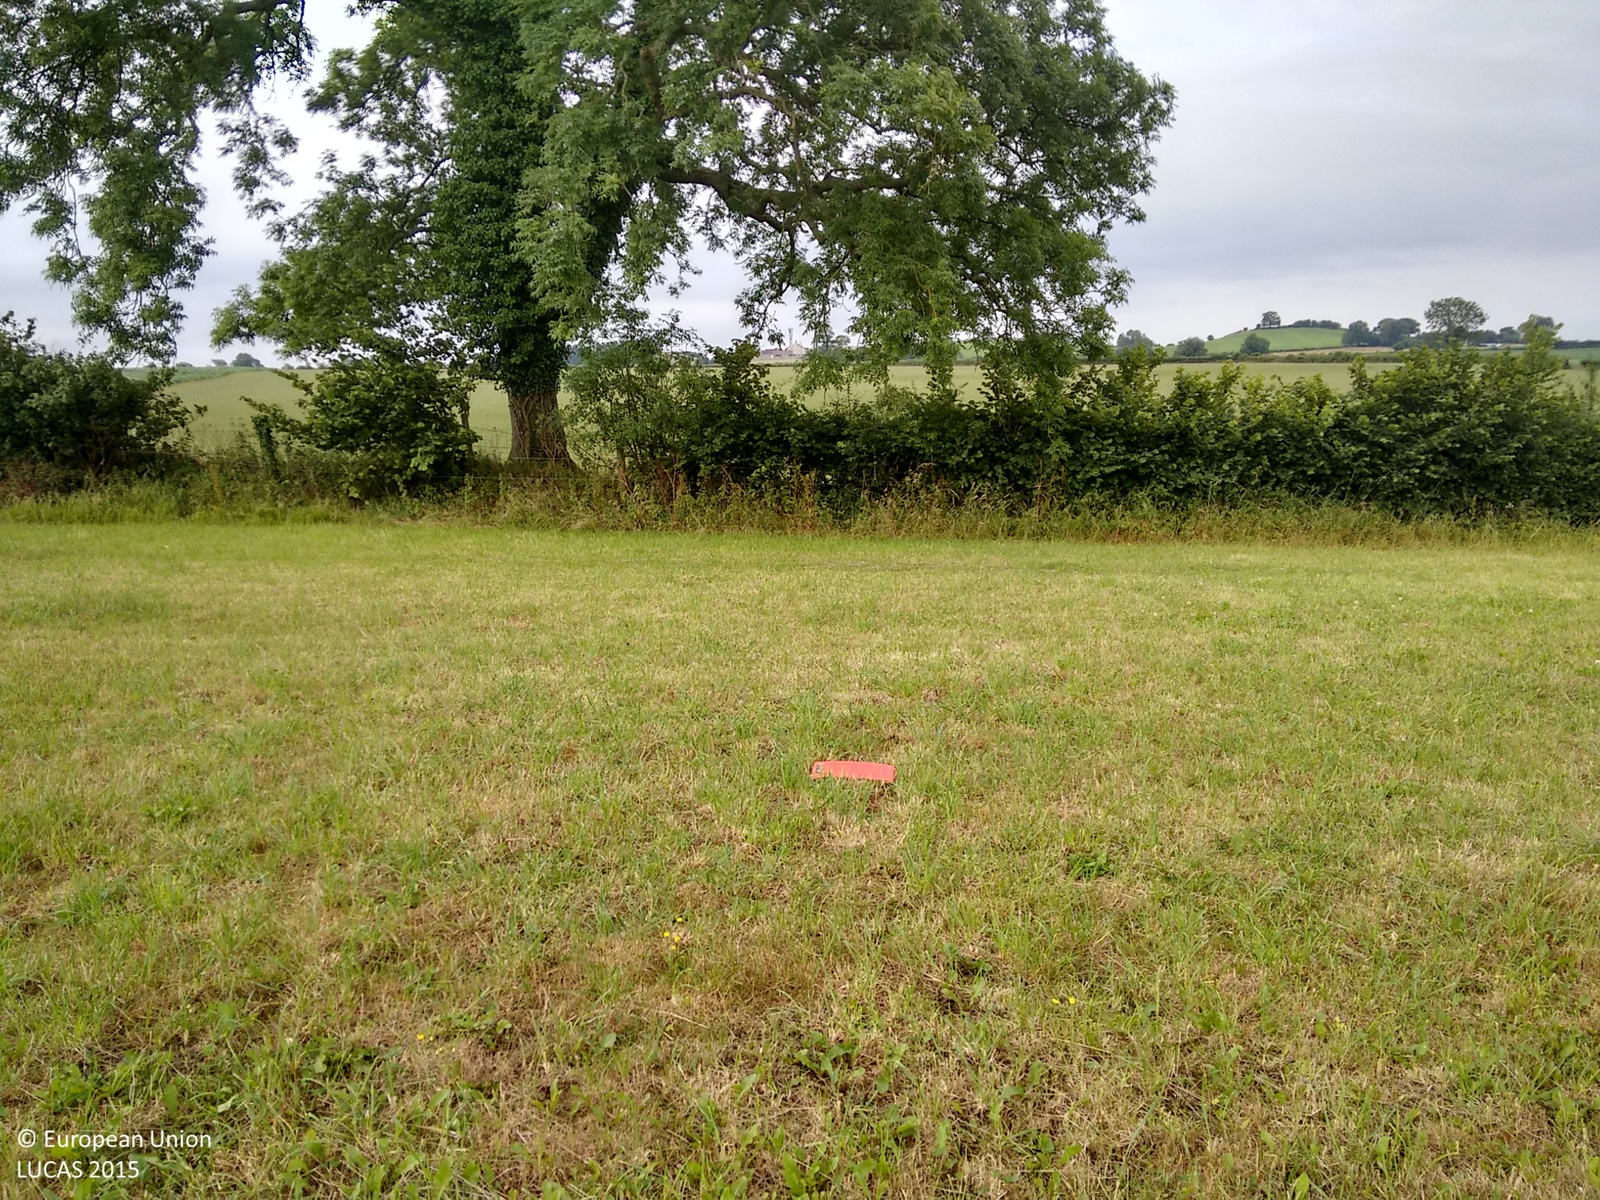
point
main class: Grassland
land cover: Grassland without tree/shrub cover
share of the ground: > 75 %
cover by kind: herbaceous plants 100 %
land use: Agriculture (excluding fallow land and kitchen gardens)
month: July
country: GB
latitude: 51.3479
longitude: -2.5147
